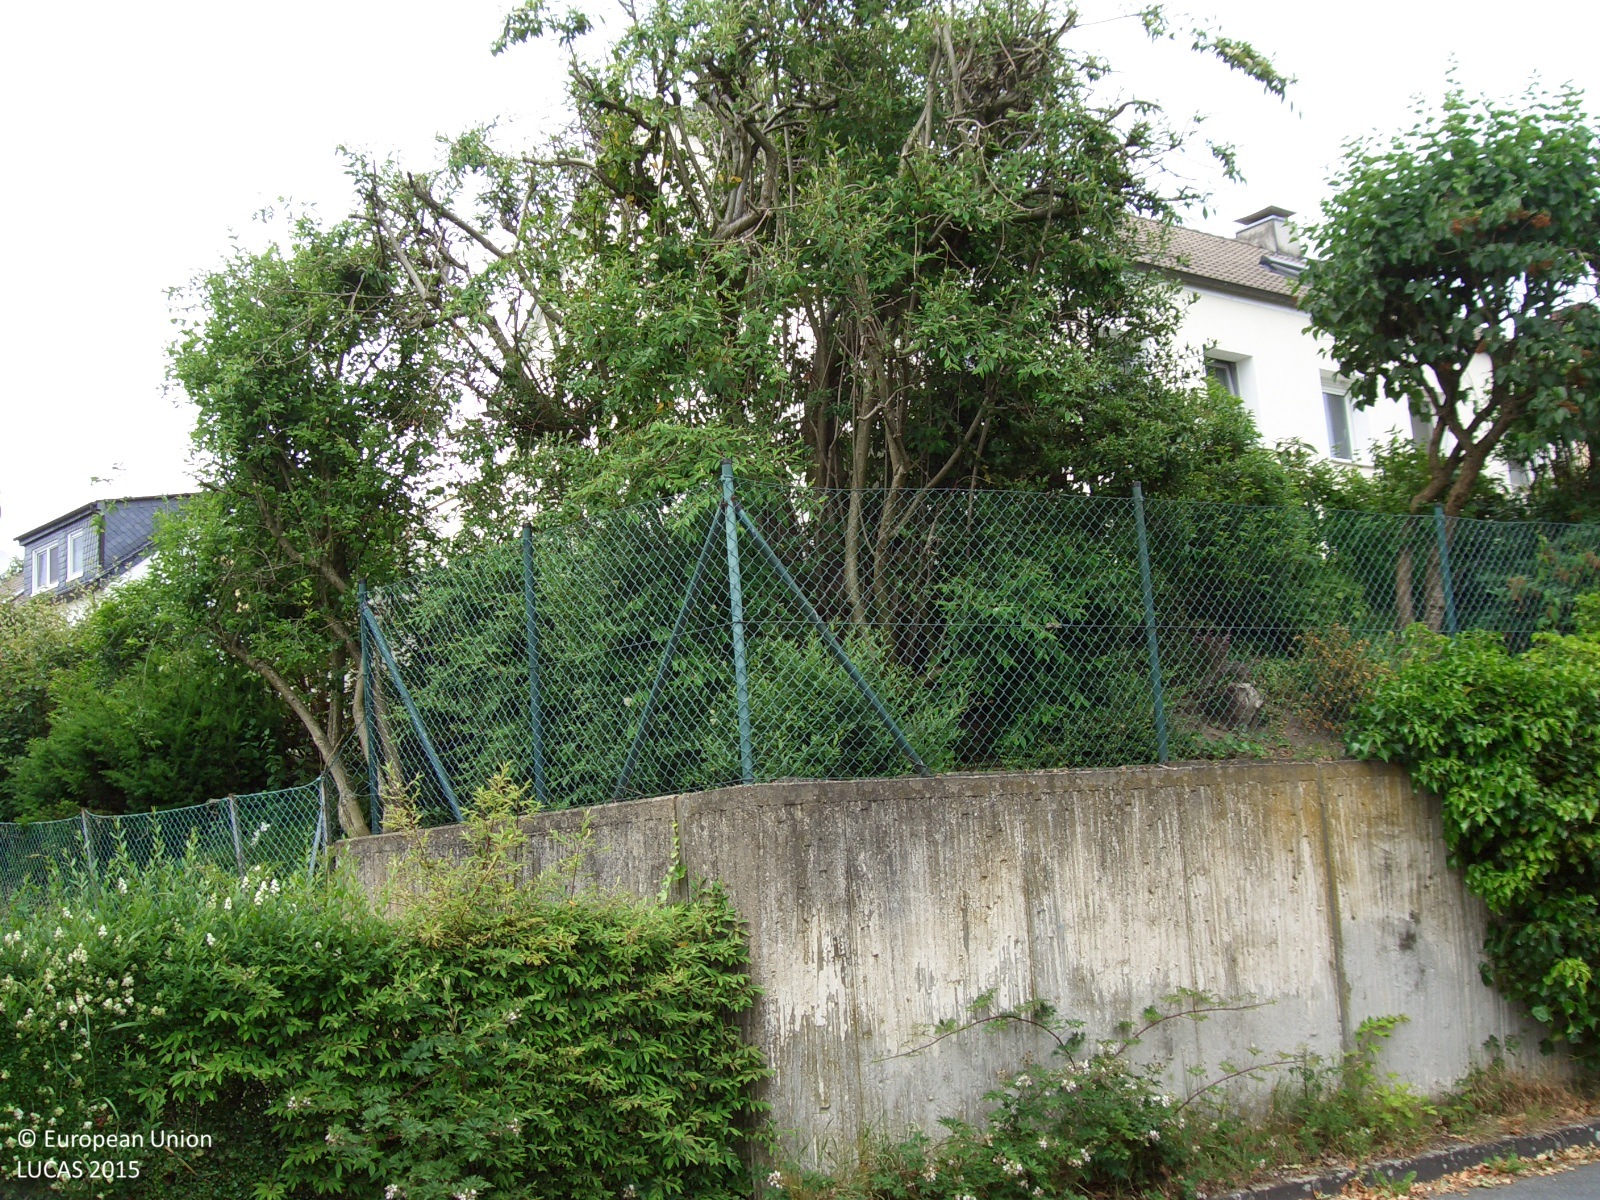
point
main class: Woodland
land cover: Broadleaved woodland
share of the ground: > 75 %
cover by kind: broadleaved forest trees 100 %
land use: Residential
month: June
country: DE
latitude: 51.1549
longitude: 7.0976
